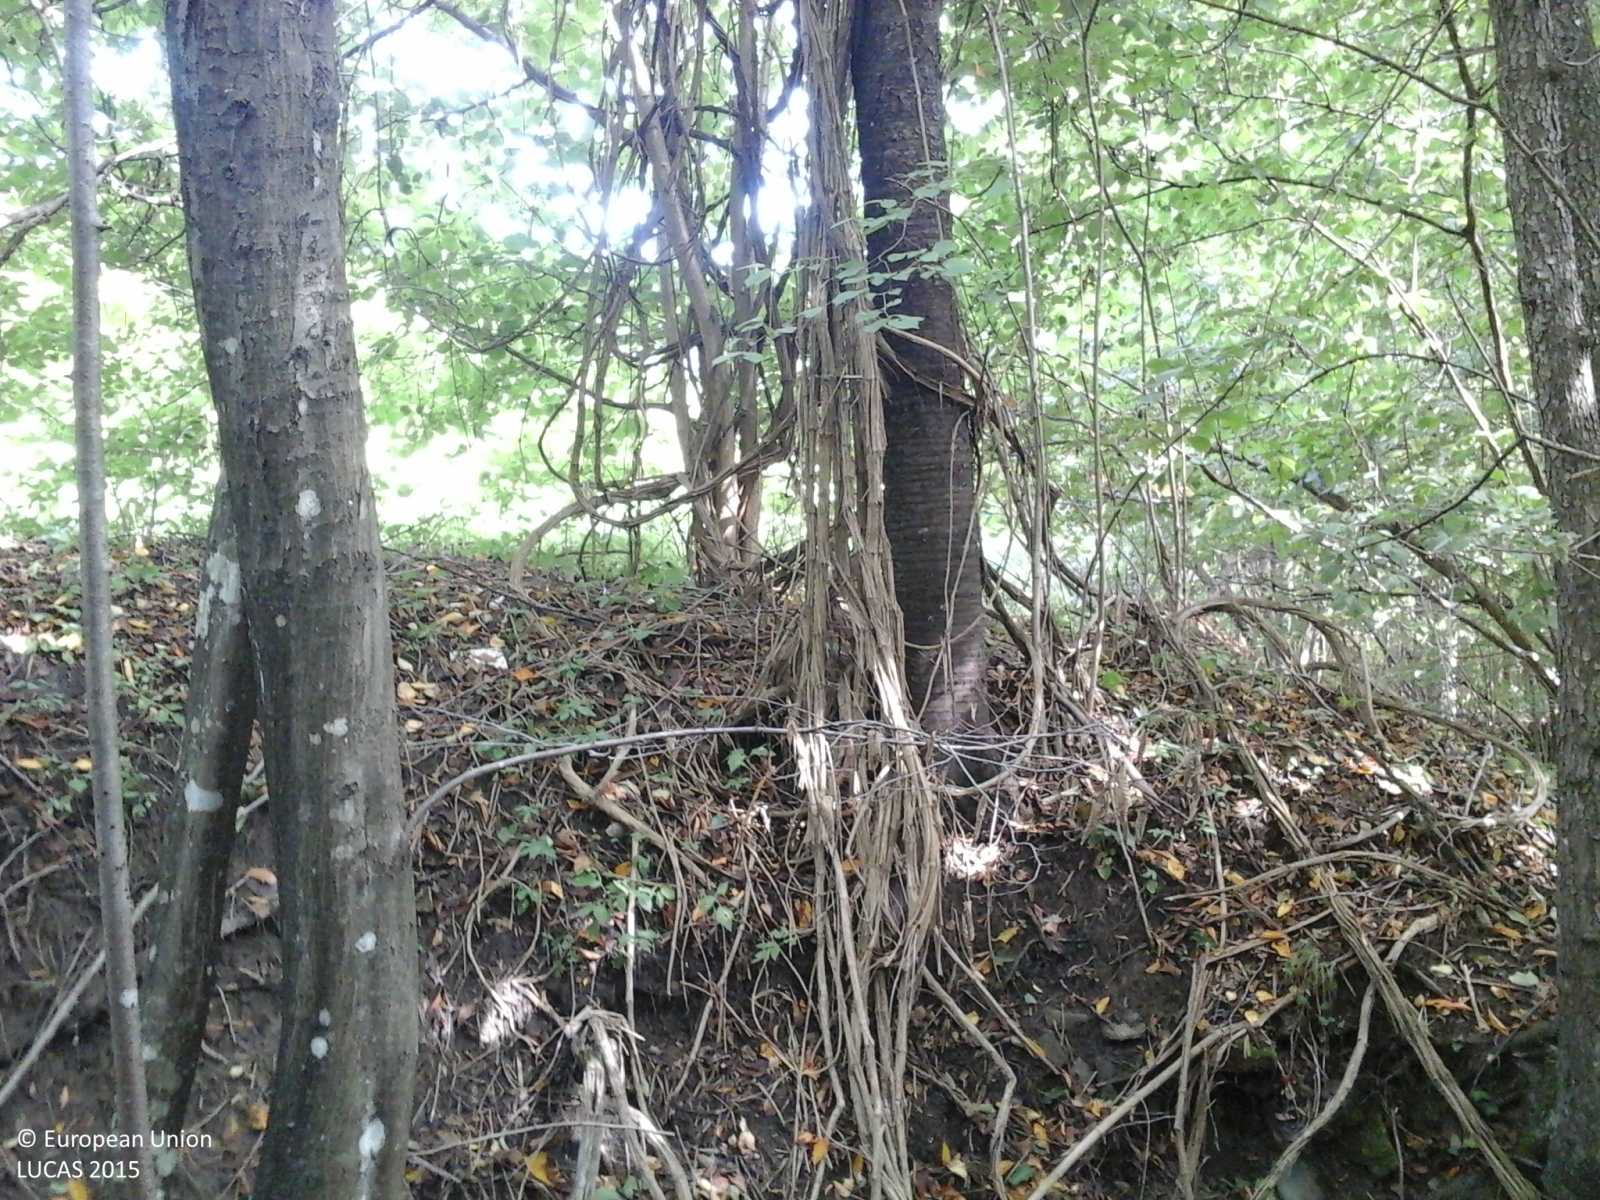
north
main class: Woodland
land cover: Broadleaved woodland
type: thermophilous deciduous forest
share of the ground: > 75 %
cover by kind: broadleaved forest trees 80 %, shrubs 20 %
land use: Semi-natural and natural areas not in use
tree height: > 5 m
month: September
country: IT
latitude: 44.5018
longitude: 8.4814
